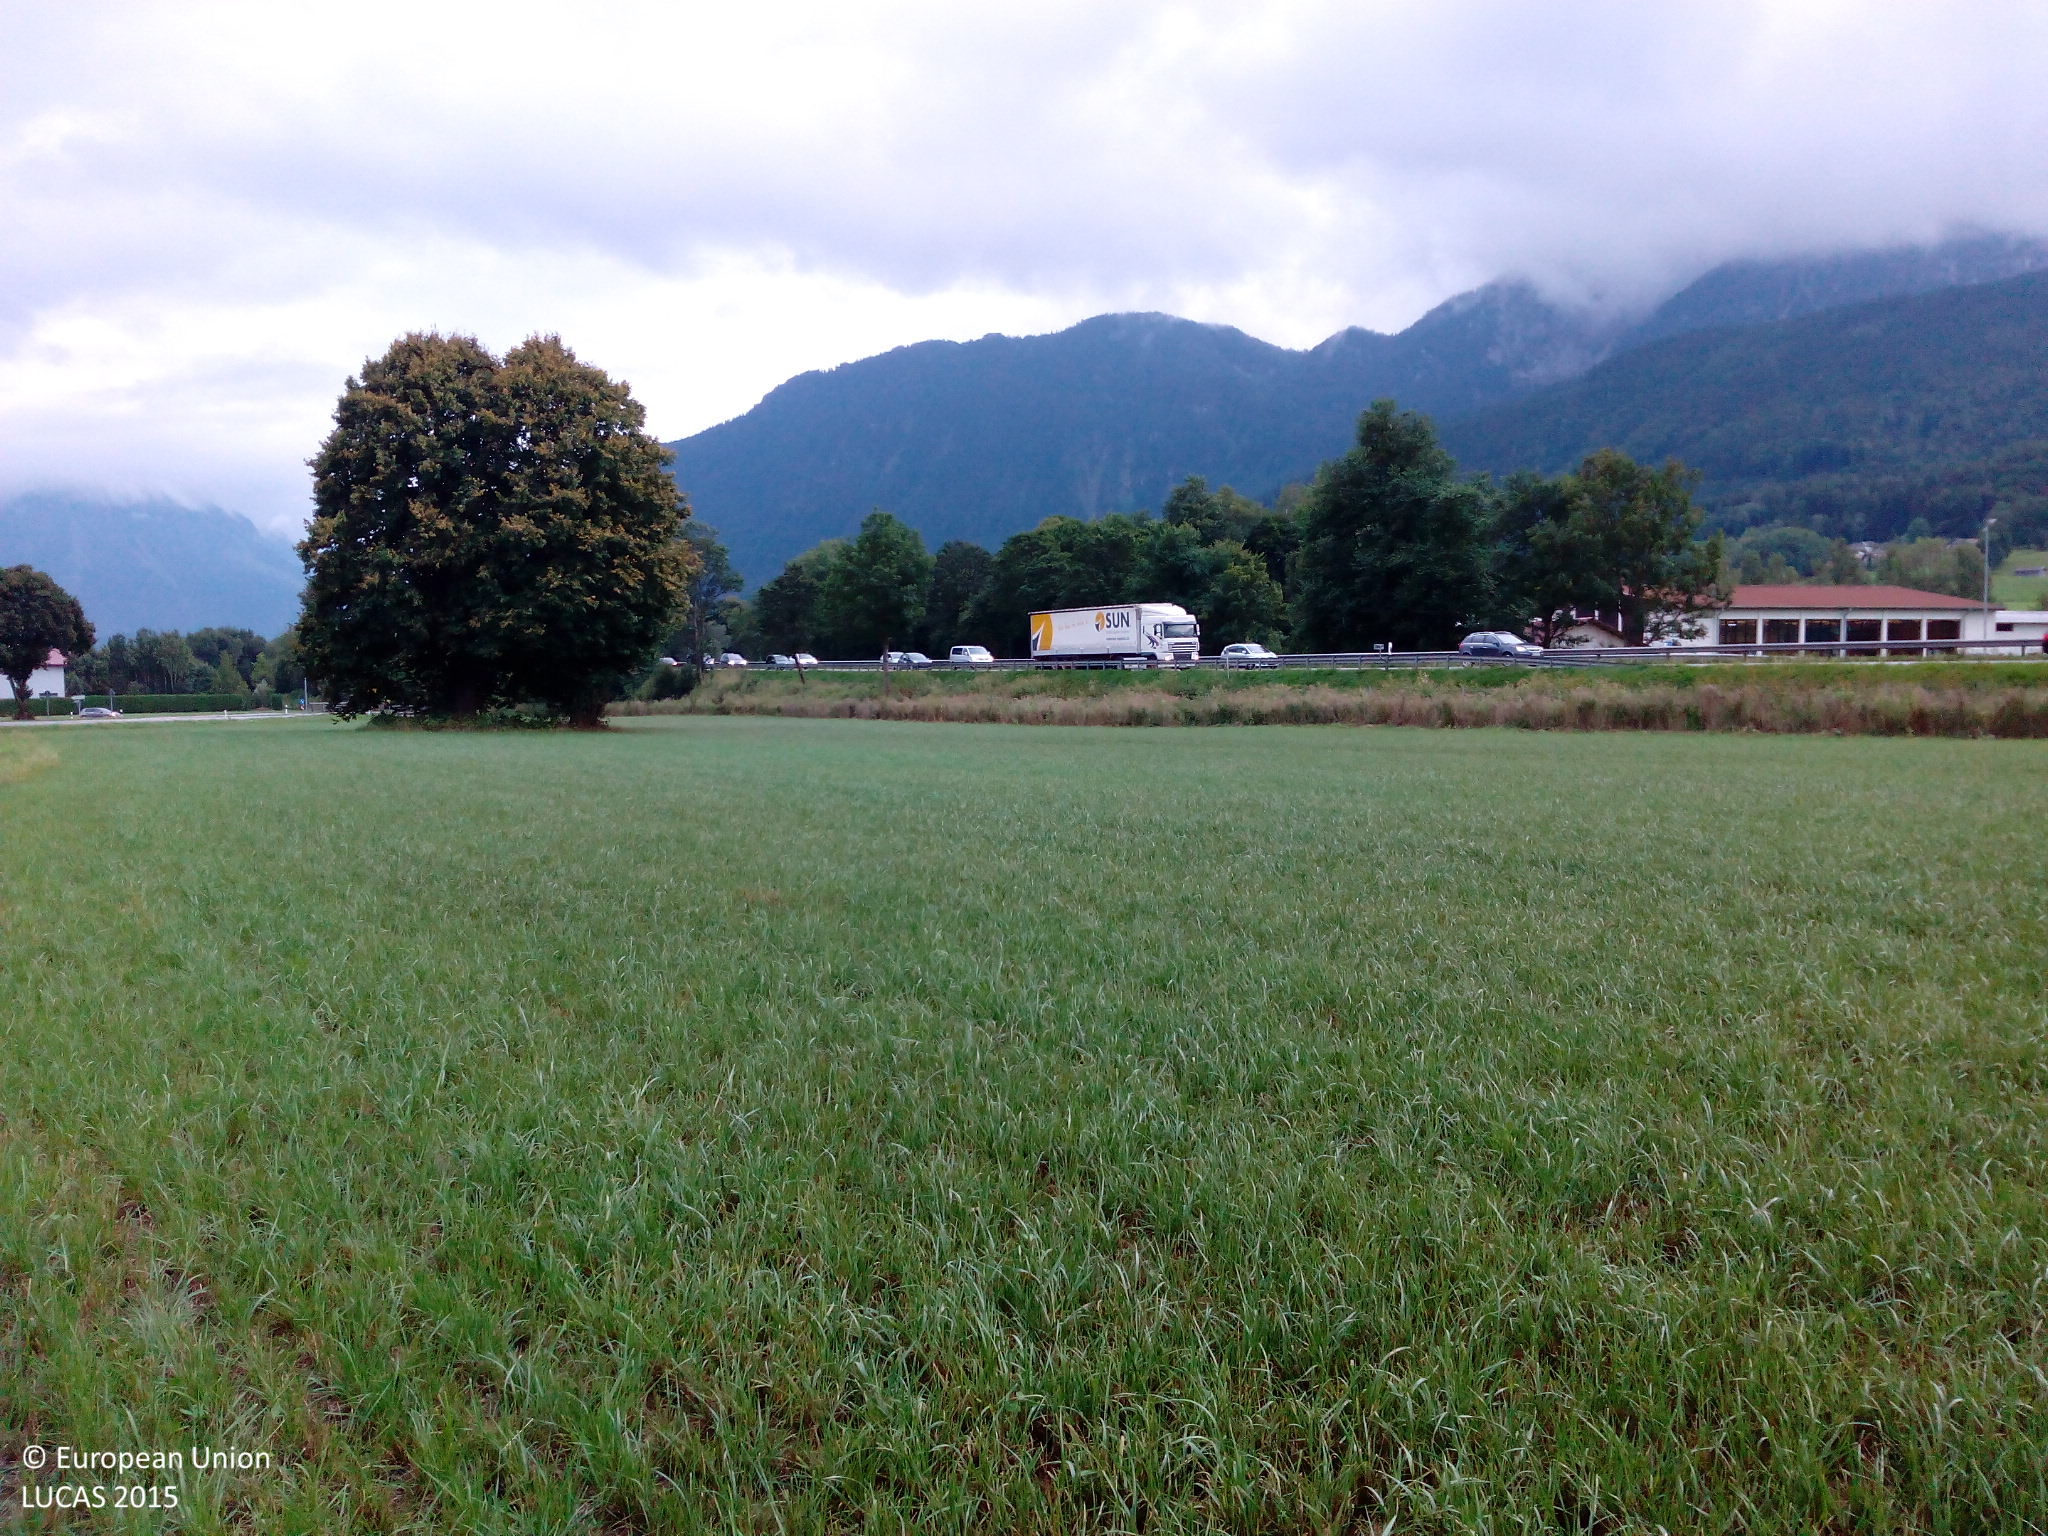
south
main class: Cropland
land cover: Temporary grasslands
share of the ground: 50 - 75 %
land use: Agriculture (excluding fallow land and kitchen gardens)
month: August
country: DE
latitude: 47.7901
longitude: 12.8686
